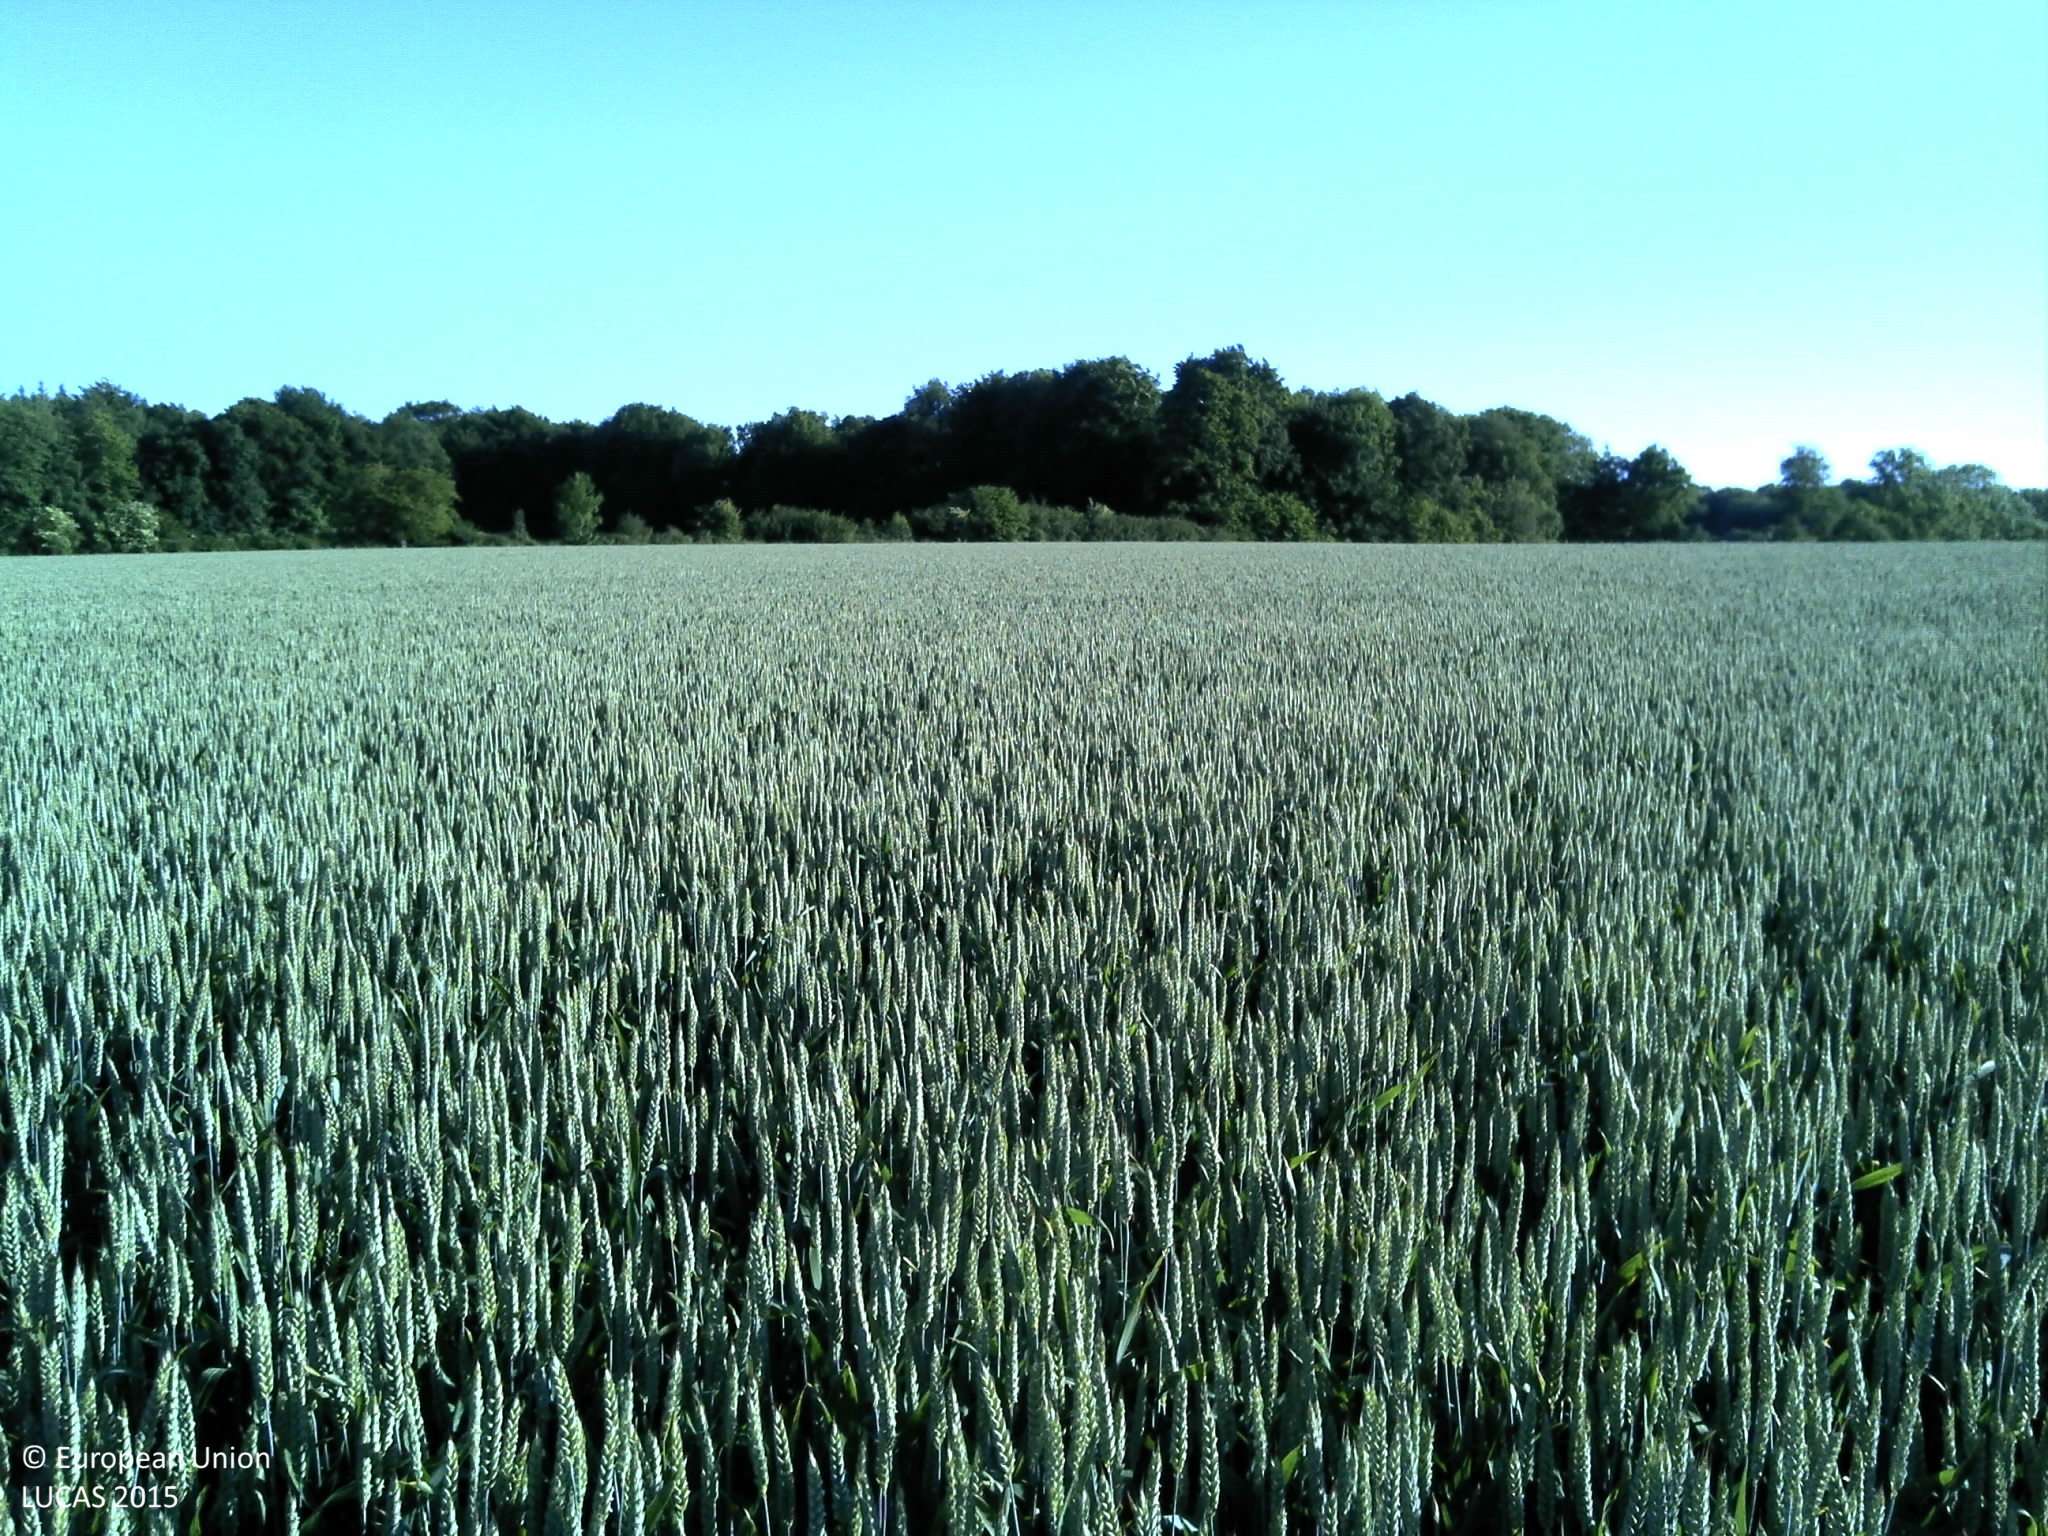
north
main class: Cropland
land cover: Common wheat
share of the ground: > 75 %
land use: Agriculture (excluding fallow land and kitchen gardens)
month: June
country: FR
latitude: 49.6102
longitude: 0.9959
